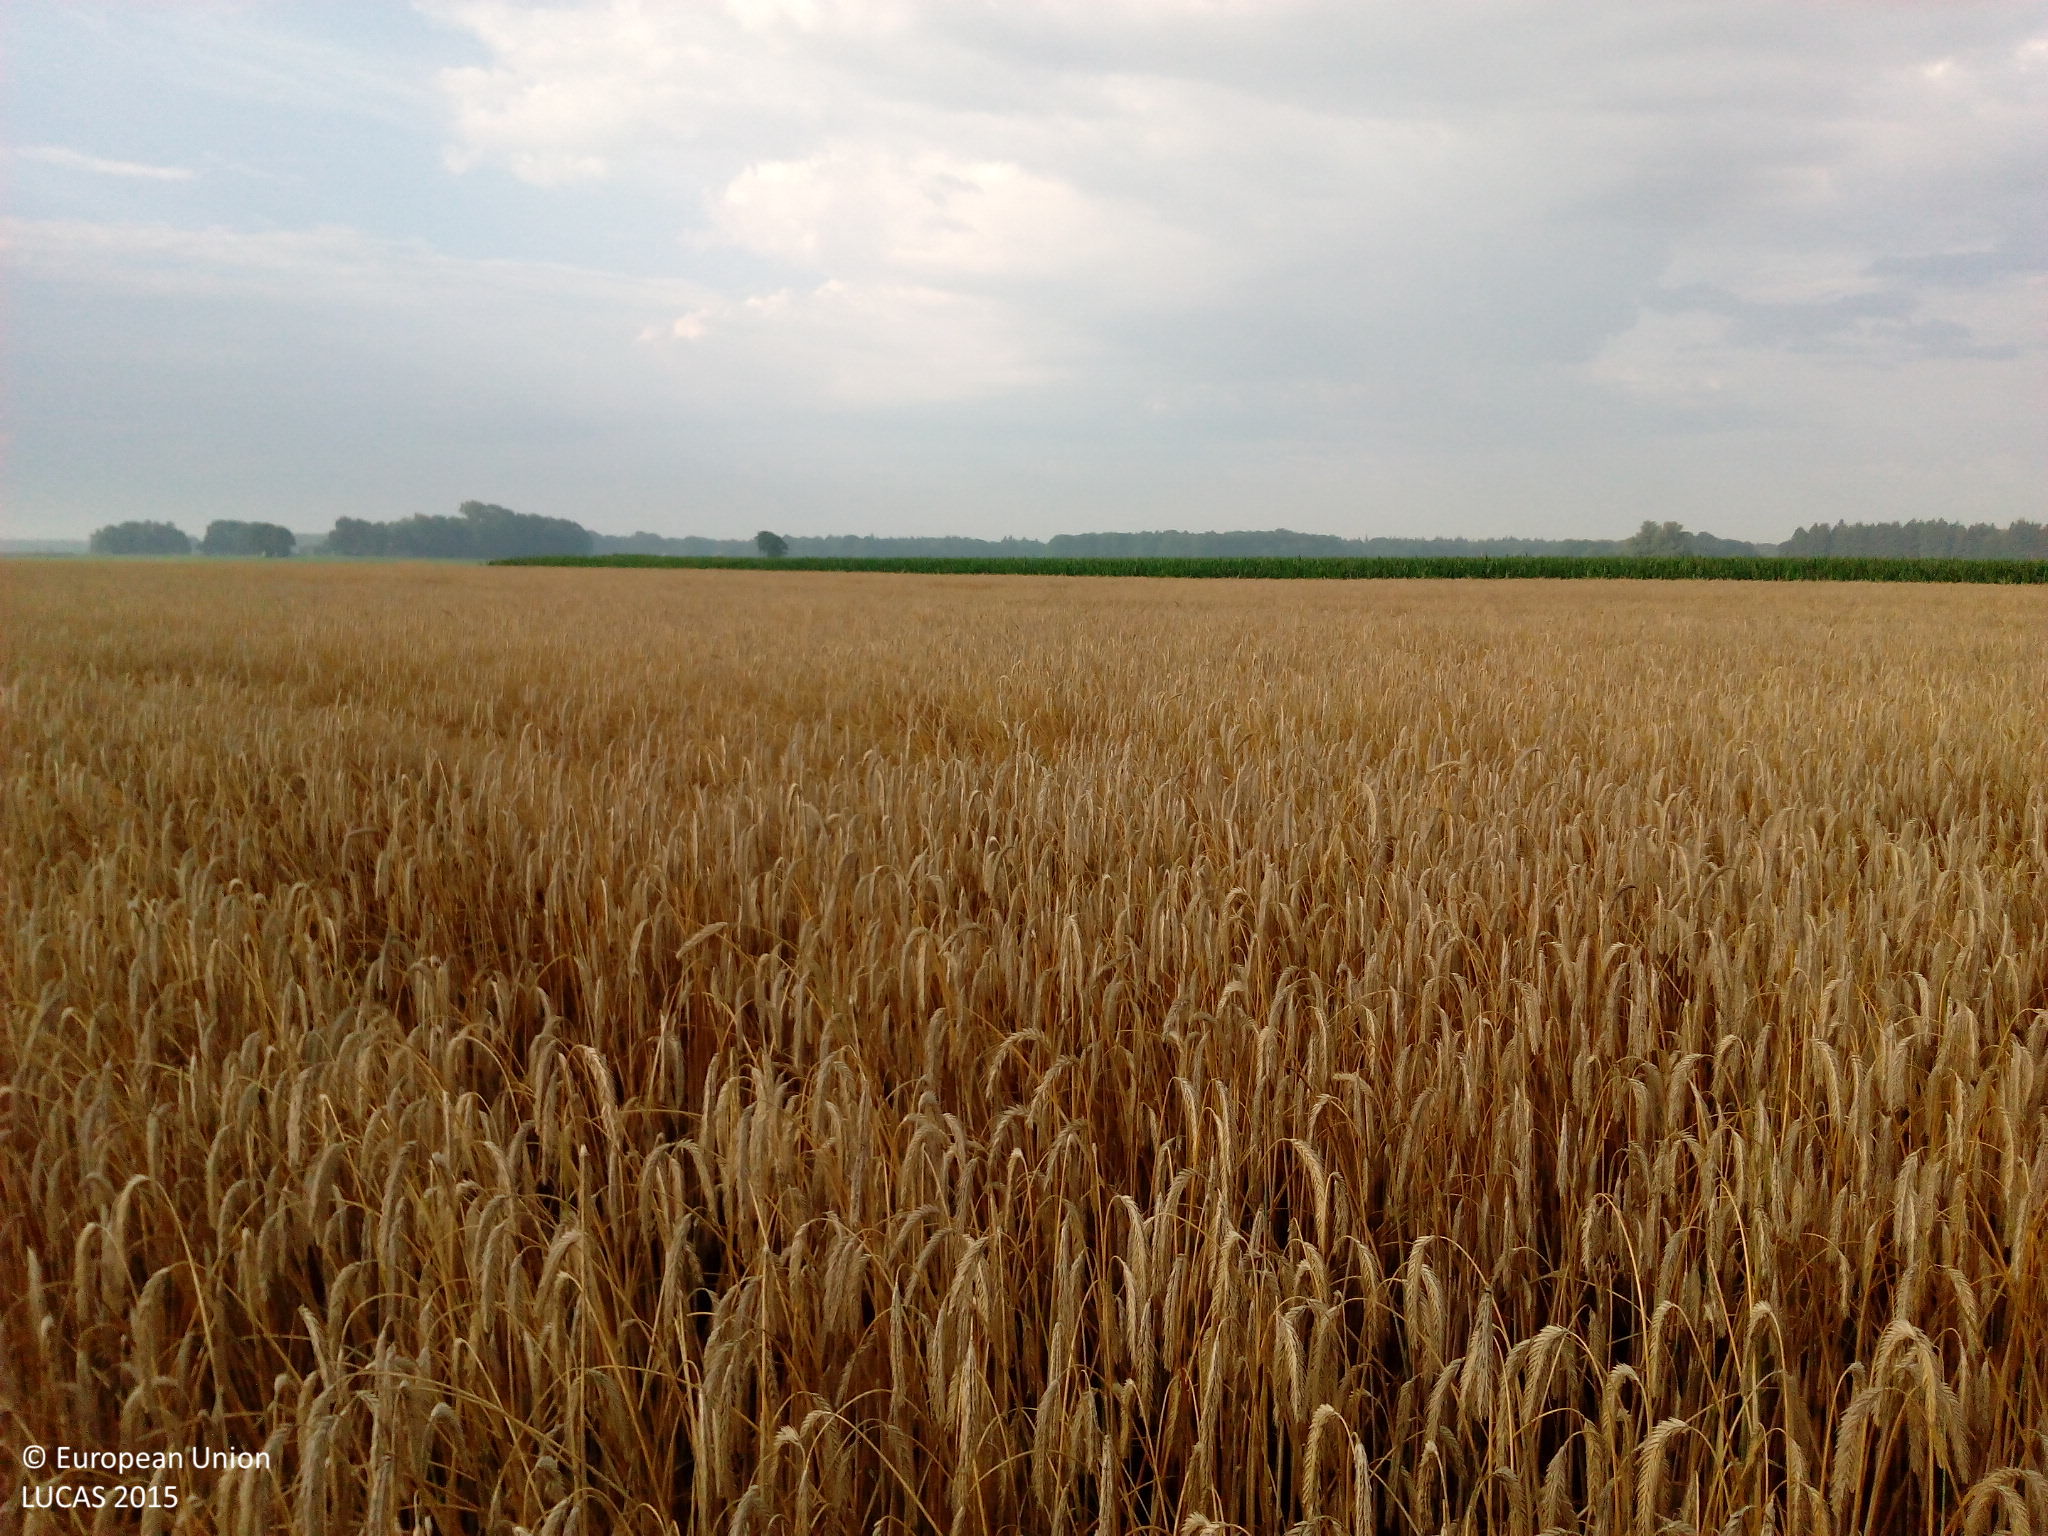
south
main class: Cropland
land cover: Rye
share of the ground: > 75 %
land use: Agriculture (excluding fallow land and kitchen gardens)
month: August
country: DE
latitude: 53.9046
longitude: 9.6501
